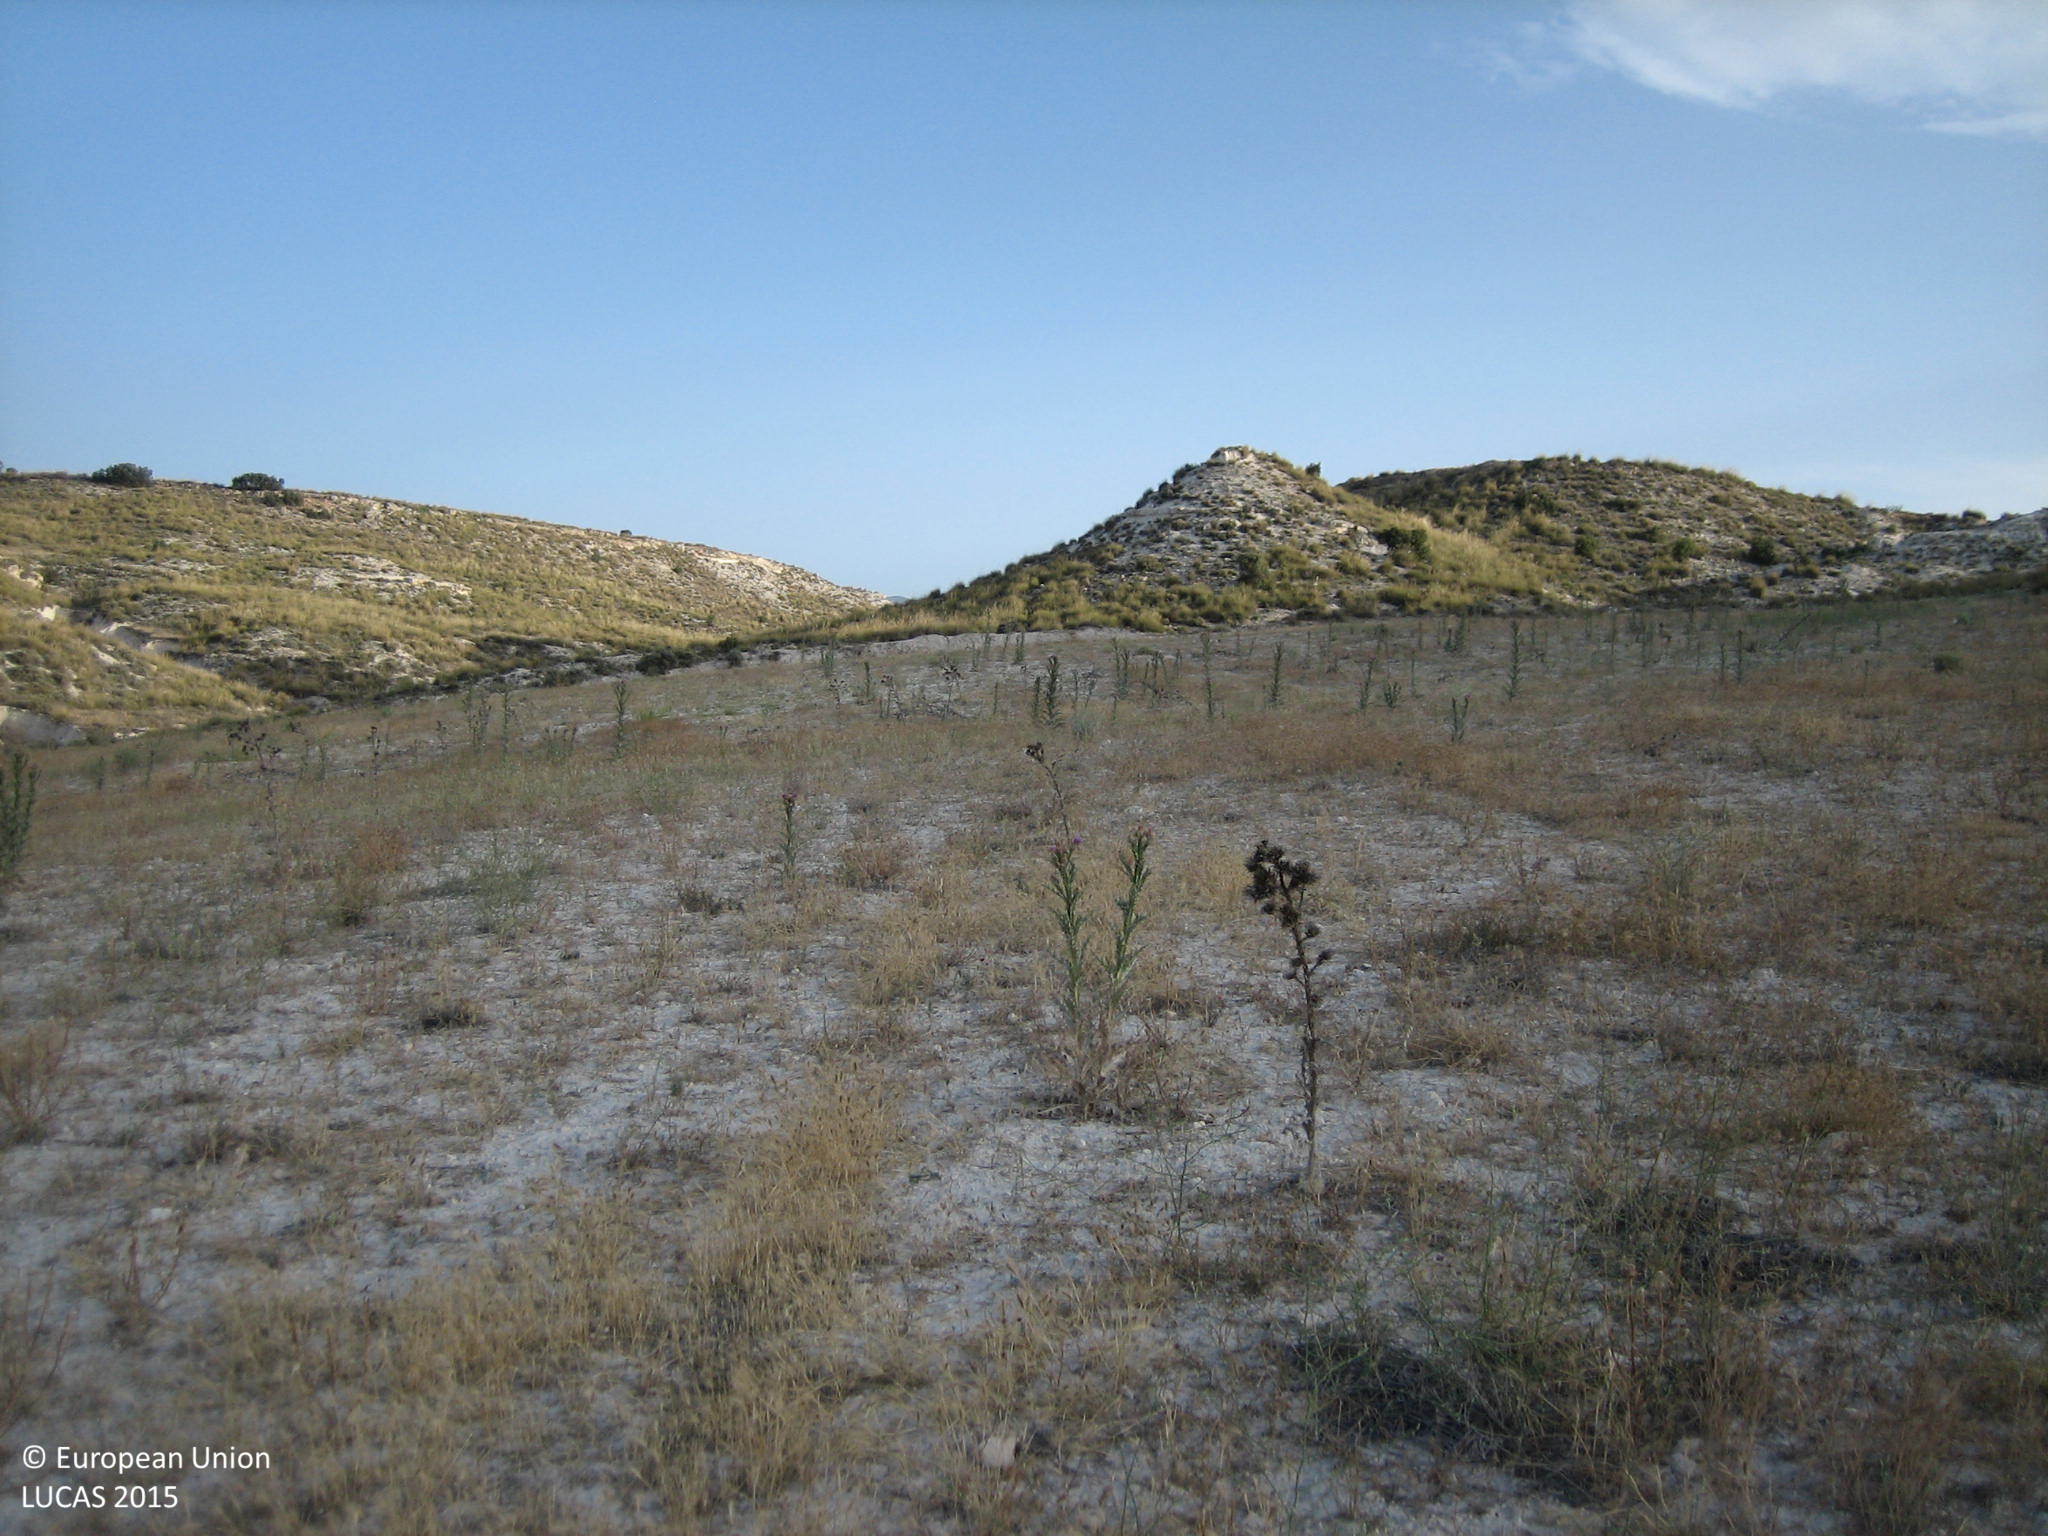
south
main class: Grassland
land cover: Spontaneously vegetated surfaces
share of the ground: 25 - 50 %
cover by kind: unconsolidated bare surface 70 %, herbaceous plants 30 %
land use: Fallow land
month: July
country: ES
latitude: 37.7370
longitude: -2.4135
